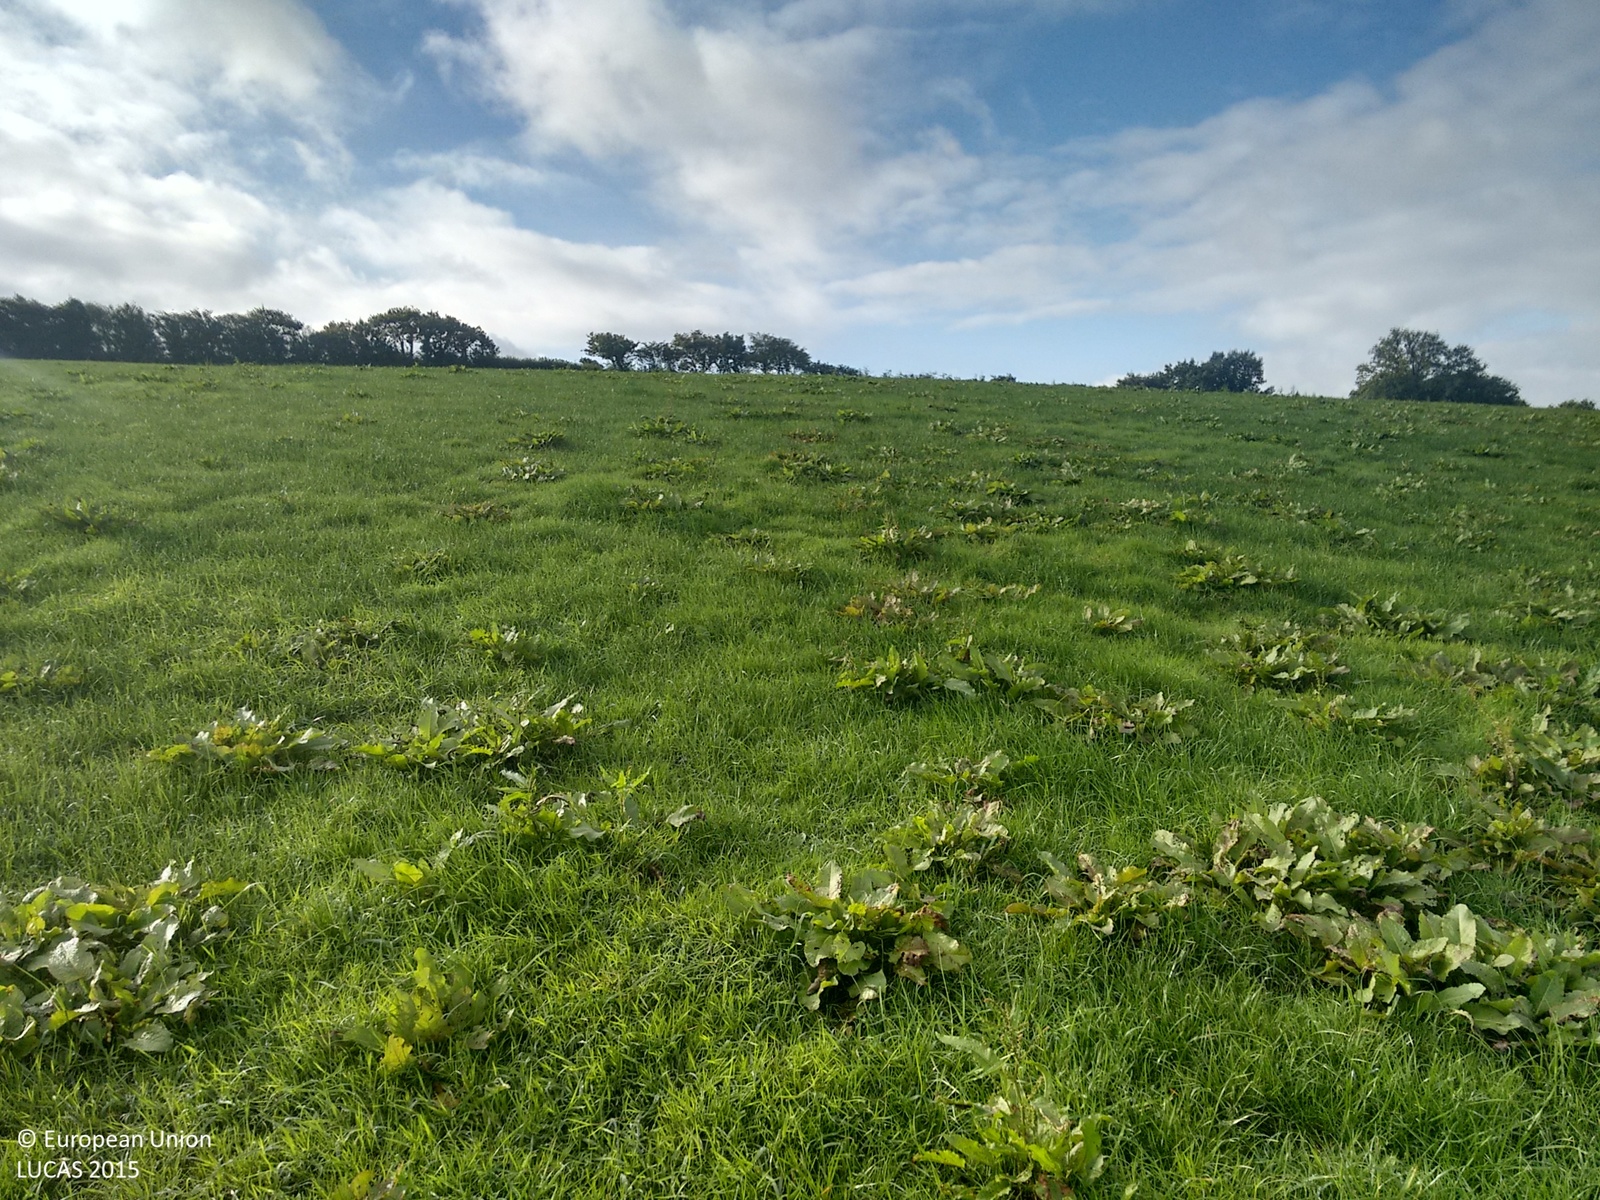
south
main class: Grassland
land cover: Grassland without tree/shrub cover
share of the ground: > 75 %
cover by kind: herbaceous plants 100 %
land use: Agriculture (excluding fallow land and kitchen gardens)
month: September
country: GB
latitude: 50.6768
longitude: -4.2072
